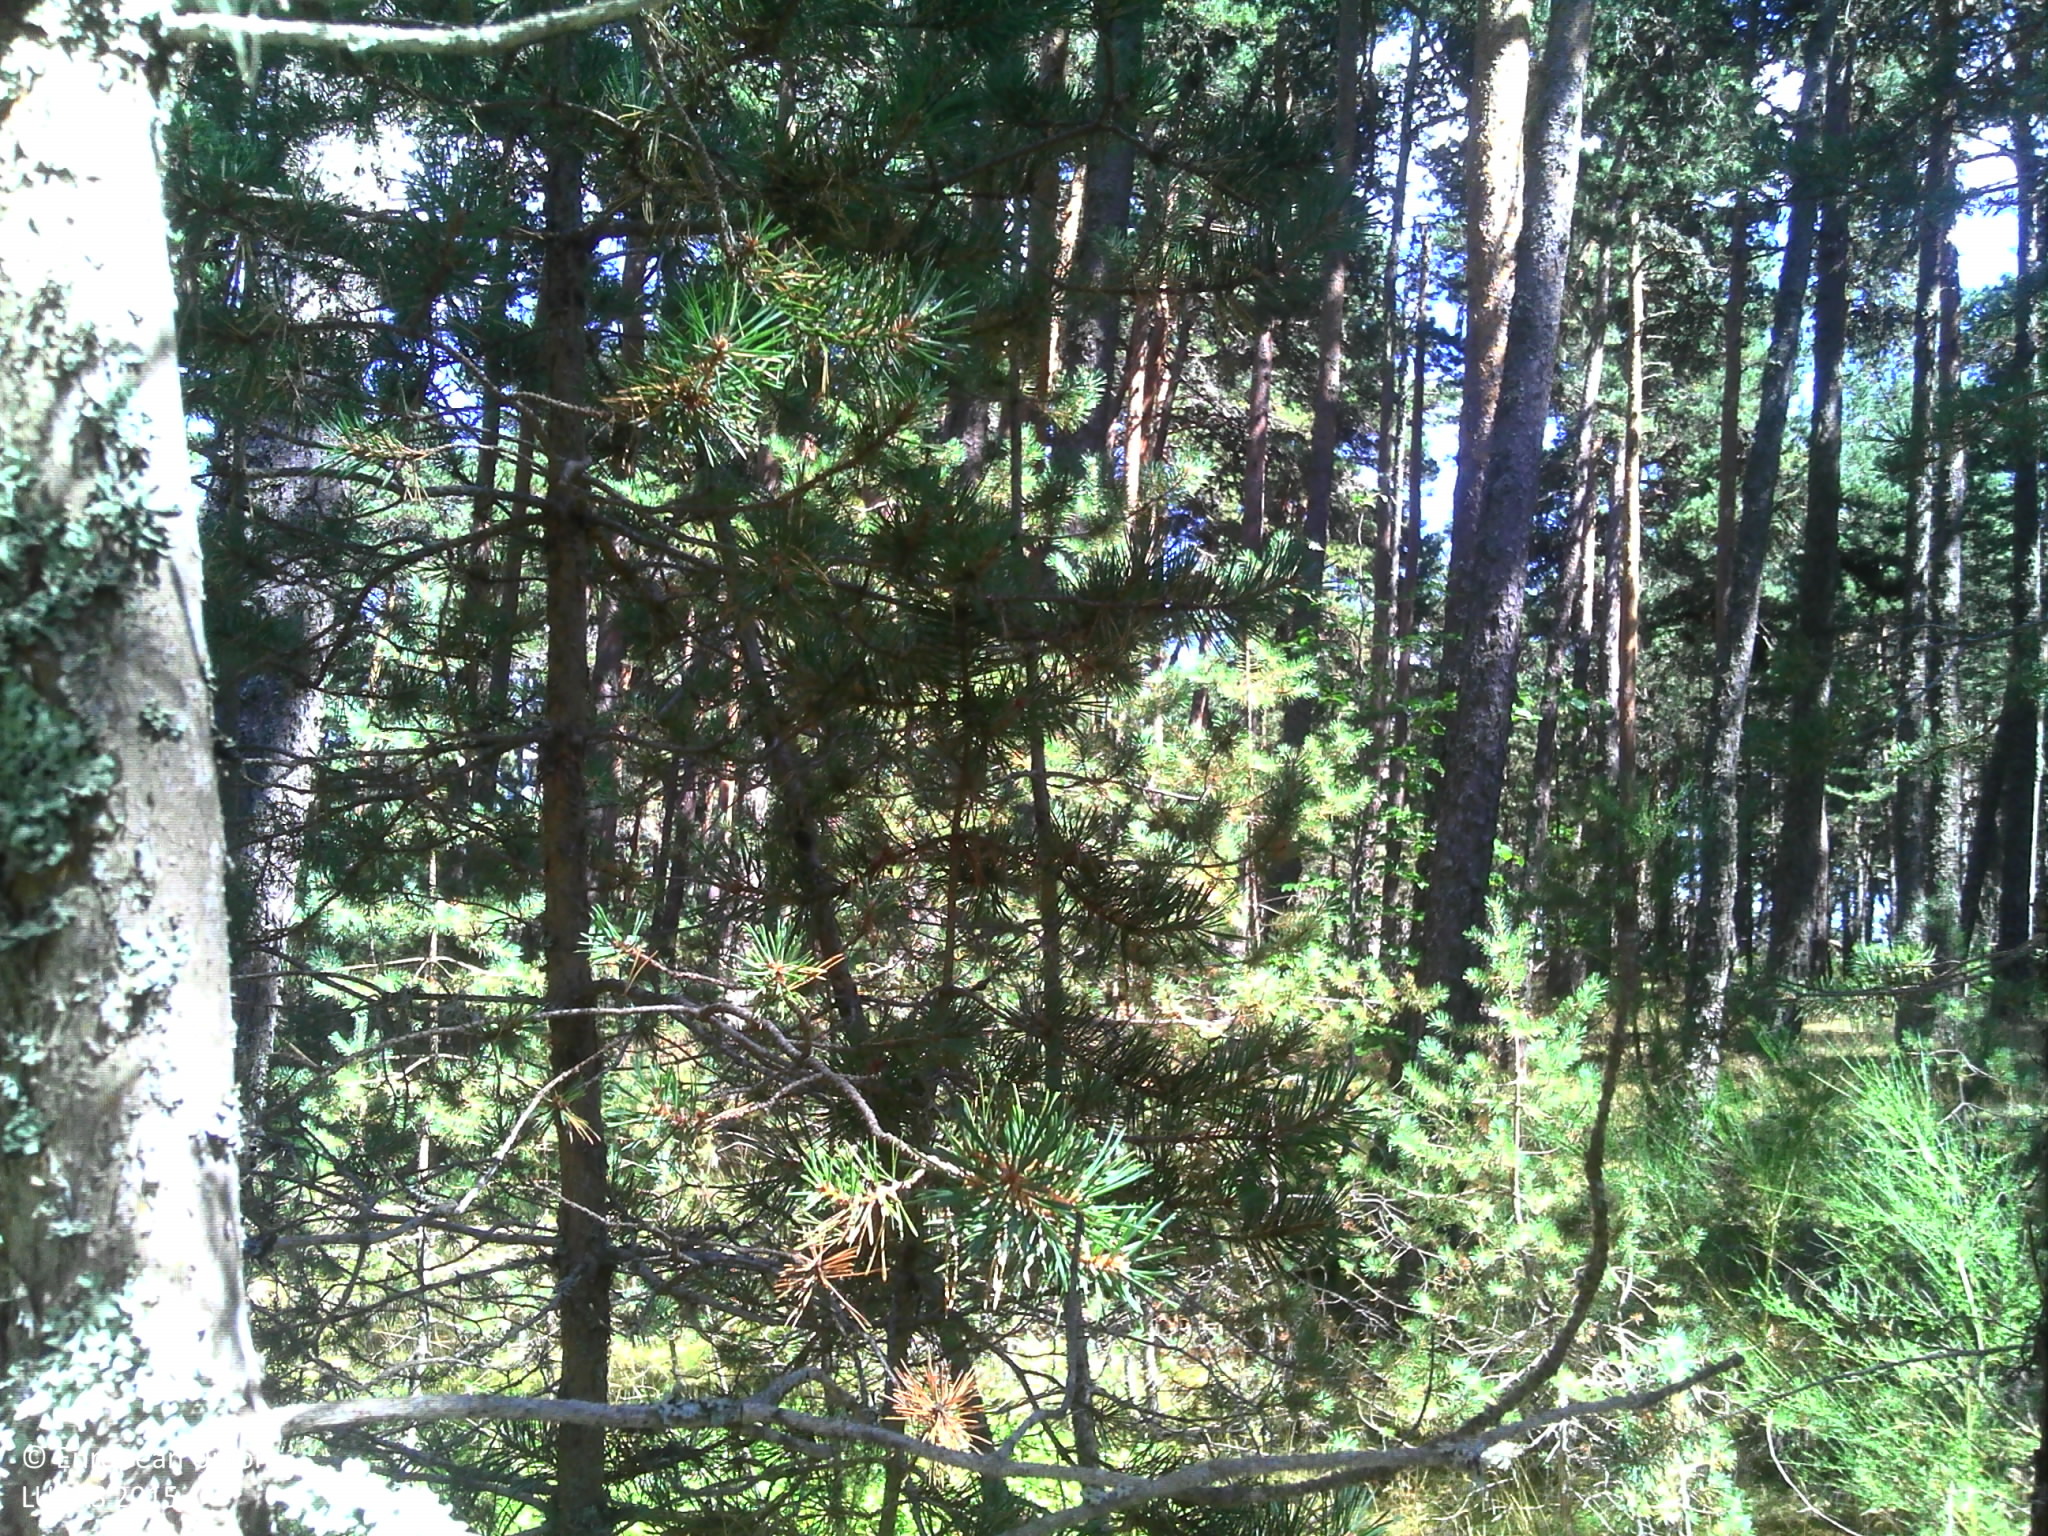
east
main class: Woodland
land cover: Pine dominated coniferous woodland
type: alpine coniferous forest
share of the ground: > 75 %
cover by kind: coniferous forest trees 75 %, herbaceous plants 20 %, broadleaved forest trees 5 %
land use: Forestry
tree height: > 5 m
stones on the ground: > 50 %
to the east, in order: Pine dominated coniferous woodland; Tracks; Pine dominated coniferous woodland; Temporary grasslands; Pine dominated coniferous woodland; Fences; Pine dominated coniferous woodland; Fences; Temporary grasslands; Fences; Pine dominated coniferous woodland
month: August
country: FR
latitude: 44.5835
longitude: 3.5438
